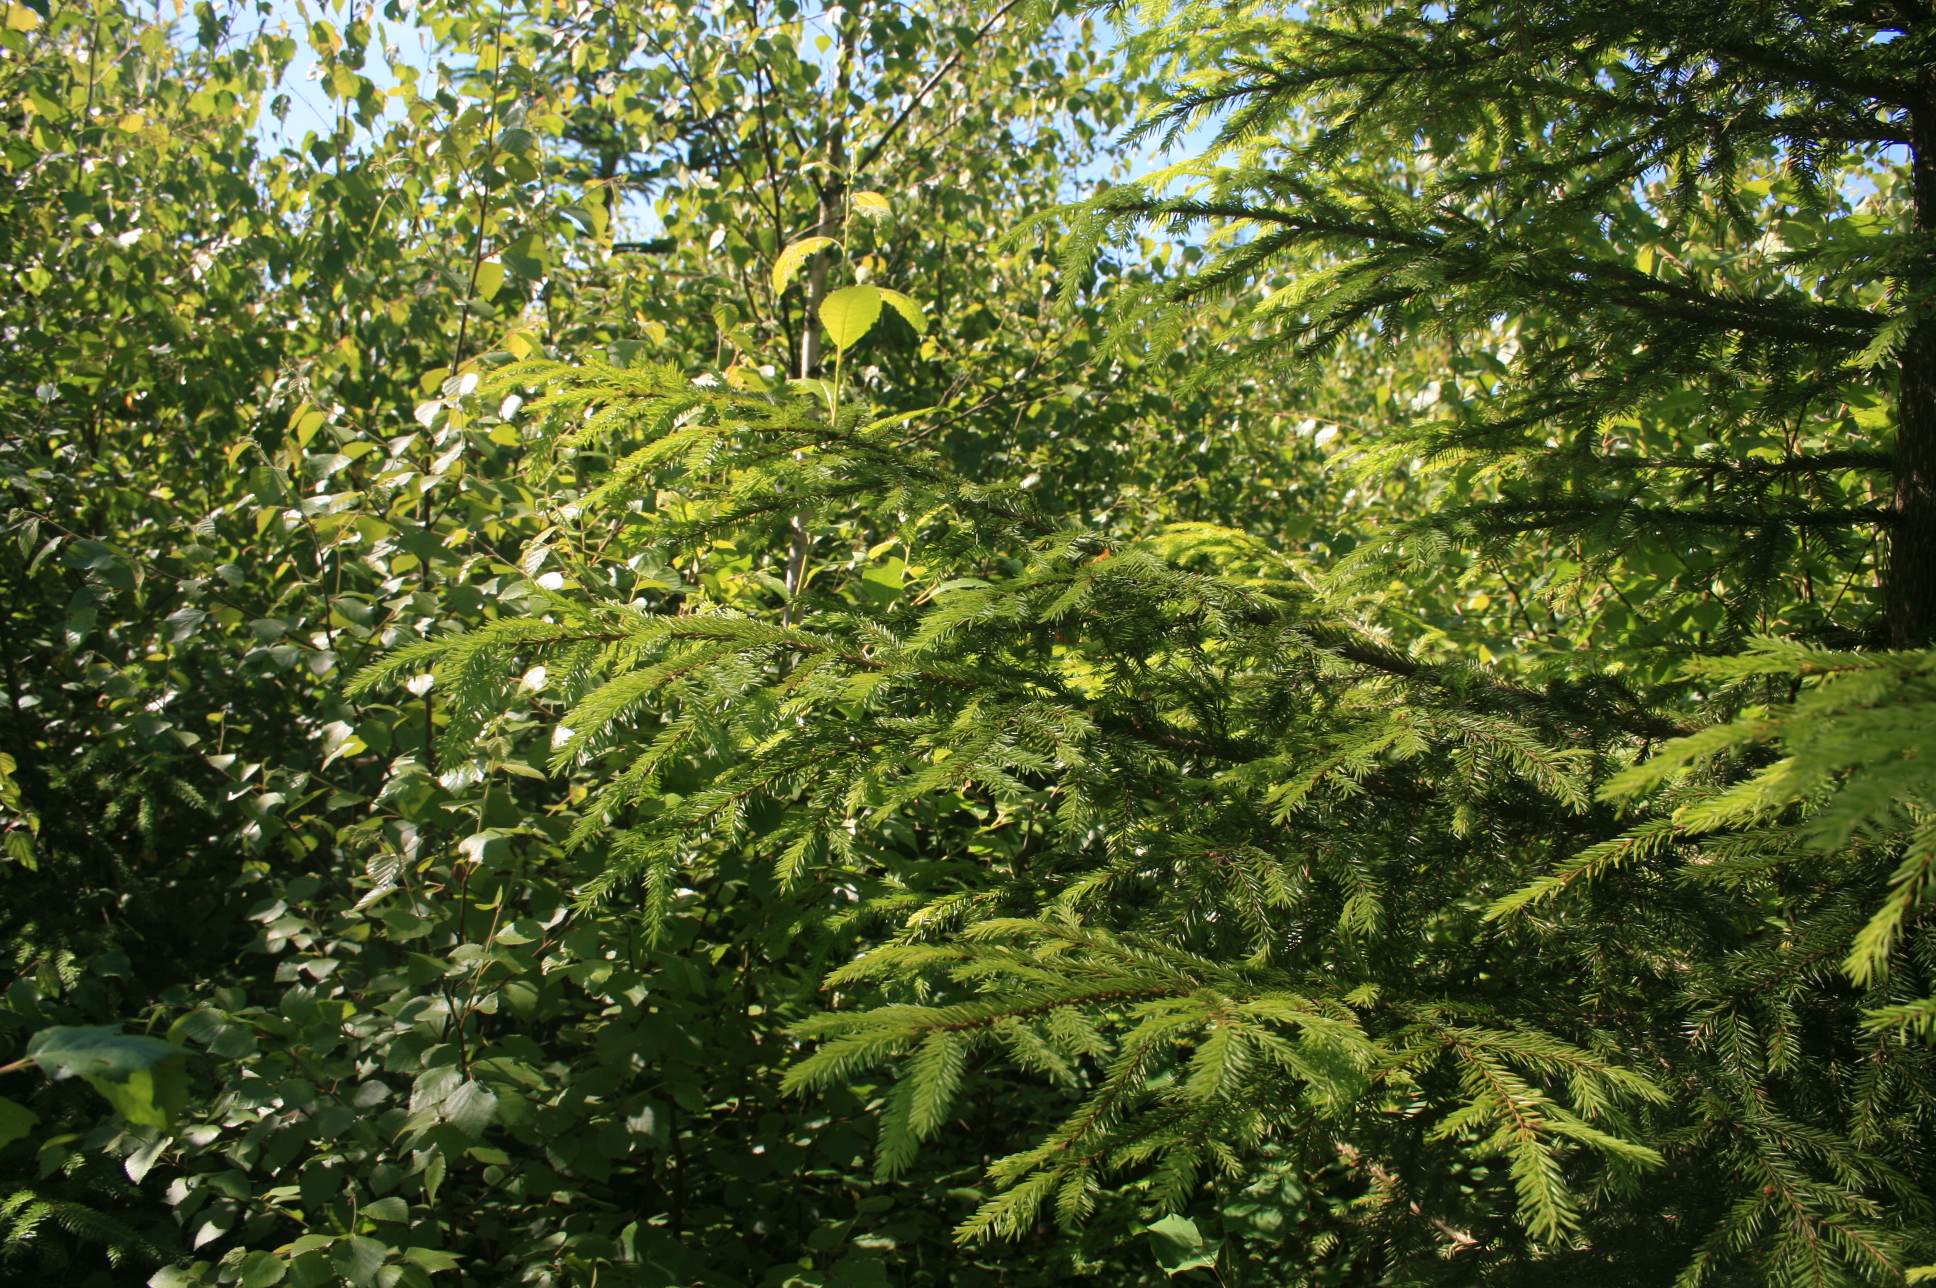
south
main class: Woodland
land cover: Spruce dominated mixed woodland
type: hemiboreal forest and nemoral coniferous forest and mixed broadleaved-coniferous forest
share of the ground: > 75 %
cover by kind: broadleaved forest trees 55 %, coniferous forest trees 45 %
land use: Forestry
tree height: < 5 m
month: June
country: LT
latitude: 55.4441
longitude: 22.1489
